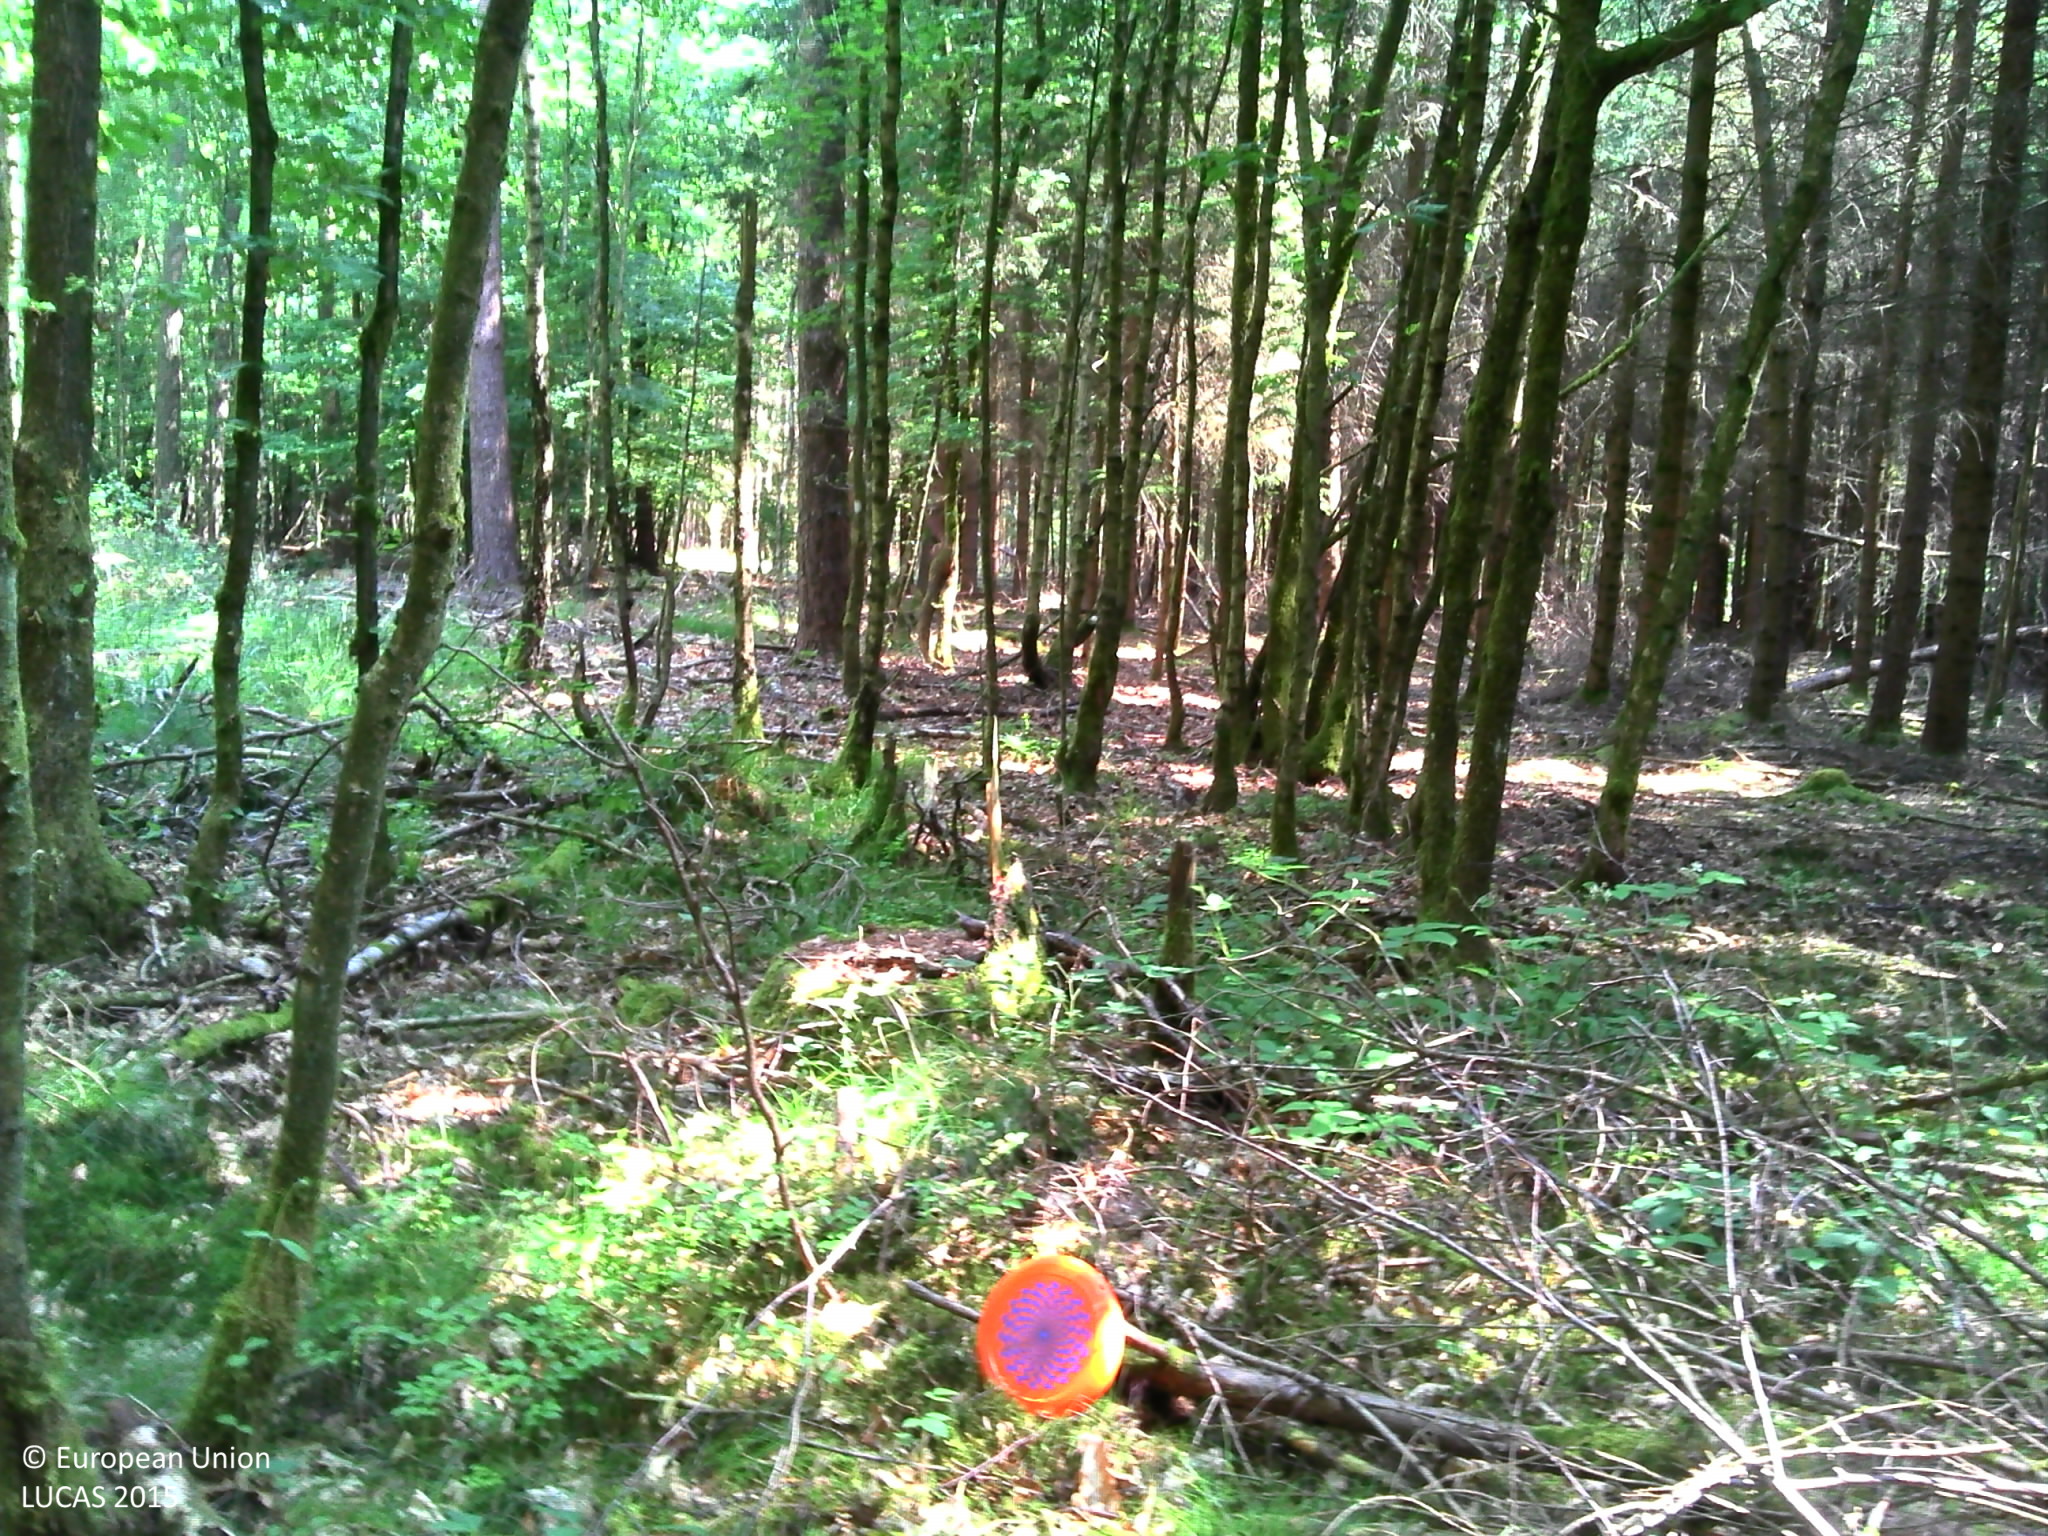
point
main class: Woodland
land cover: Pine dominated mixed woodland
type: hemiboreal forest and nemoral coniferous forest and mixed broadleaved-coniferous forest
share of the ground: > 75 %
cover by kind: broadleaved forest trees 50 %, coniferous forest trees 40 %, herbaceous plants 10 %
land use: Forestry
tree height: > 5 m
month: June
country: BE
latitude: 50.0534
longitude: 4.9272
